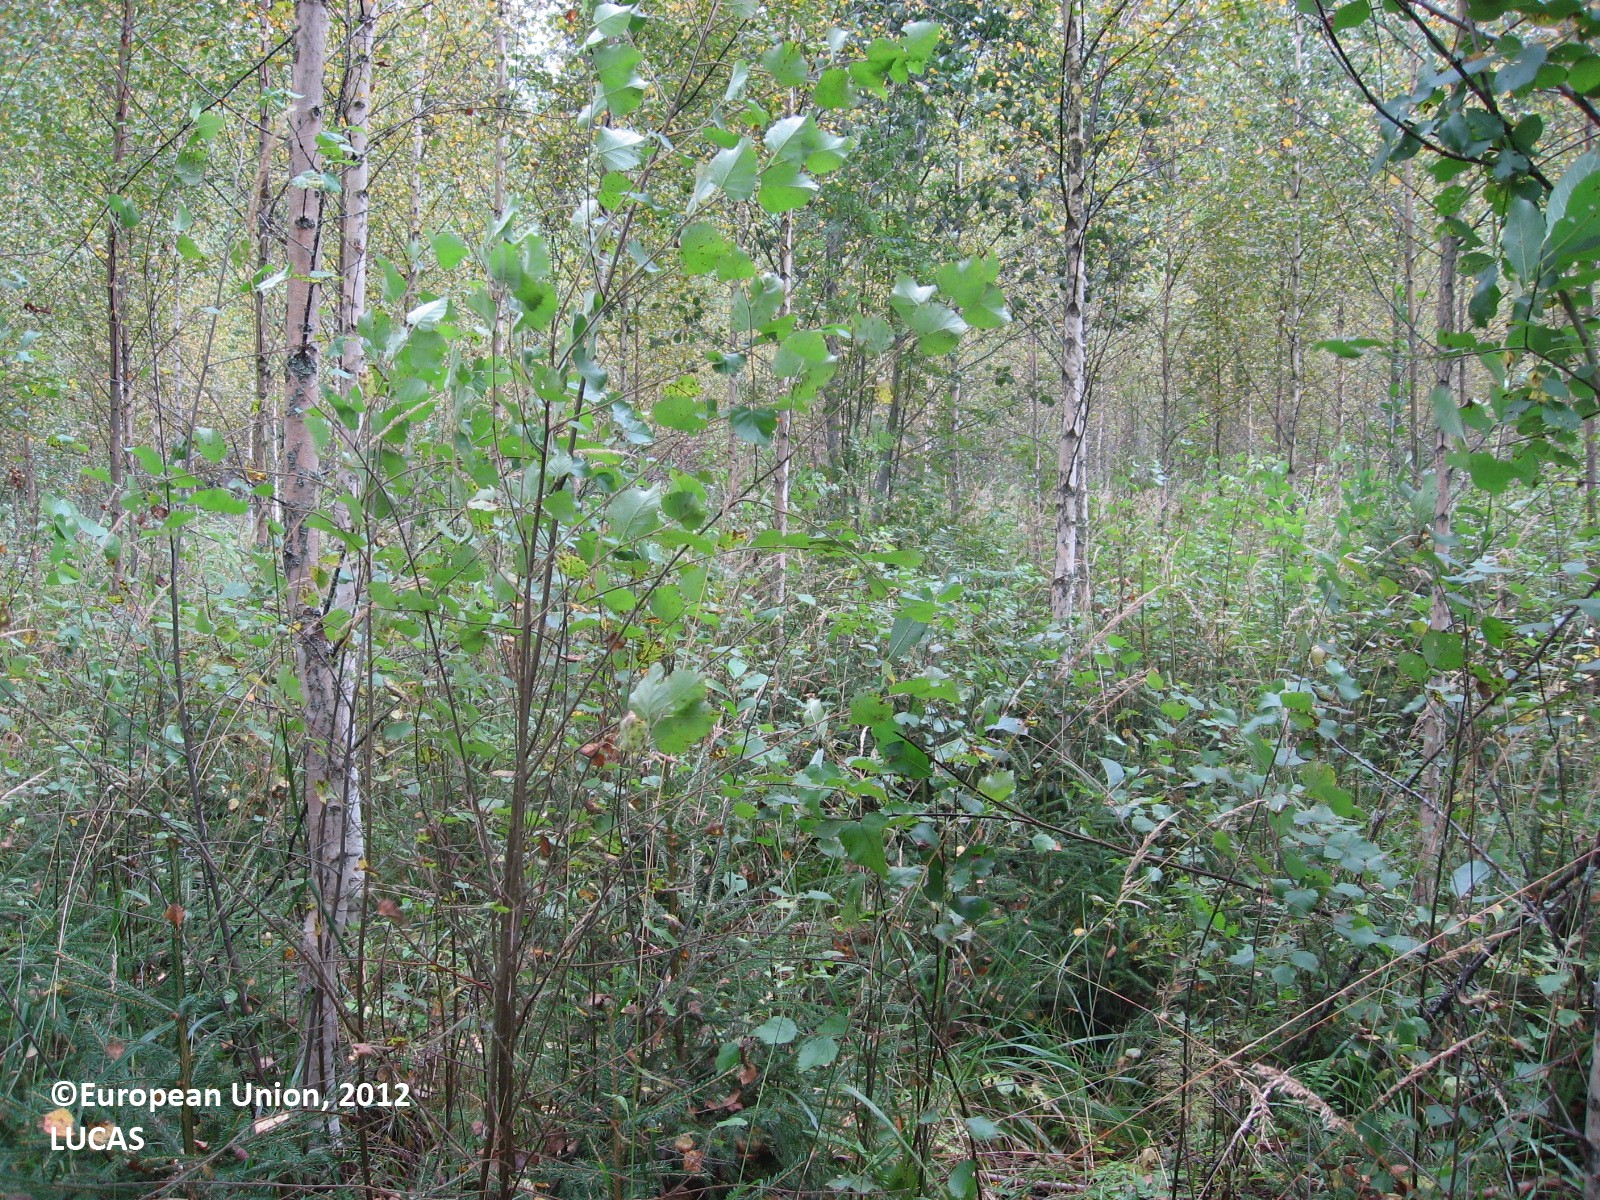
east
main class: Woodland
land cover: Broadleaved woodland
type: boreal forest
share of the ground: > 75 %
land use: Forestry
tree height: > 5 m
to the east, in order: Broadleaved woodland; Spruce dominated mixed woodland; Ditches and canals; Spruce dominated coniferous woodland; Ditches and canals; Spruce dominated coniferous woodland; Ditches and canals; Spruce dominated coniferous woodland; Spruce dominated mixed woodland; Ditches and canals; Grass margins; Oats
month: September
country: FI
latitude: 60.8797
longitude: 25.1685
